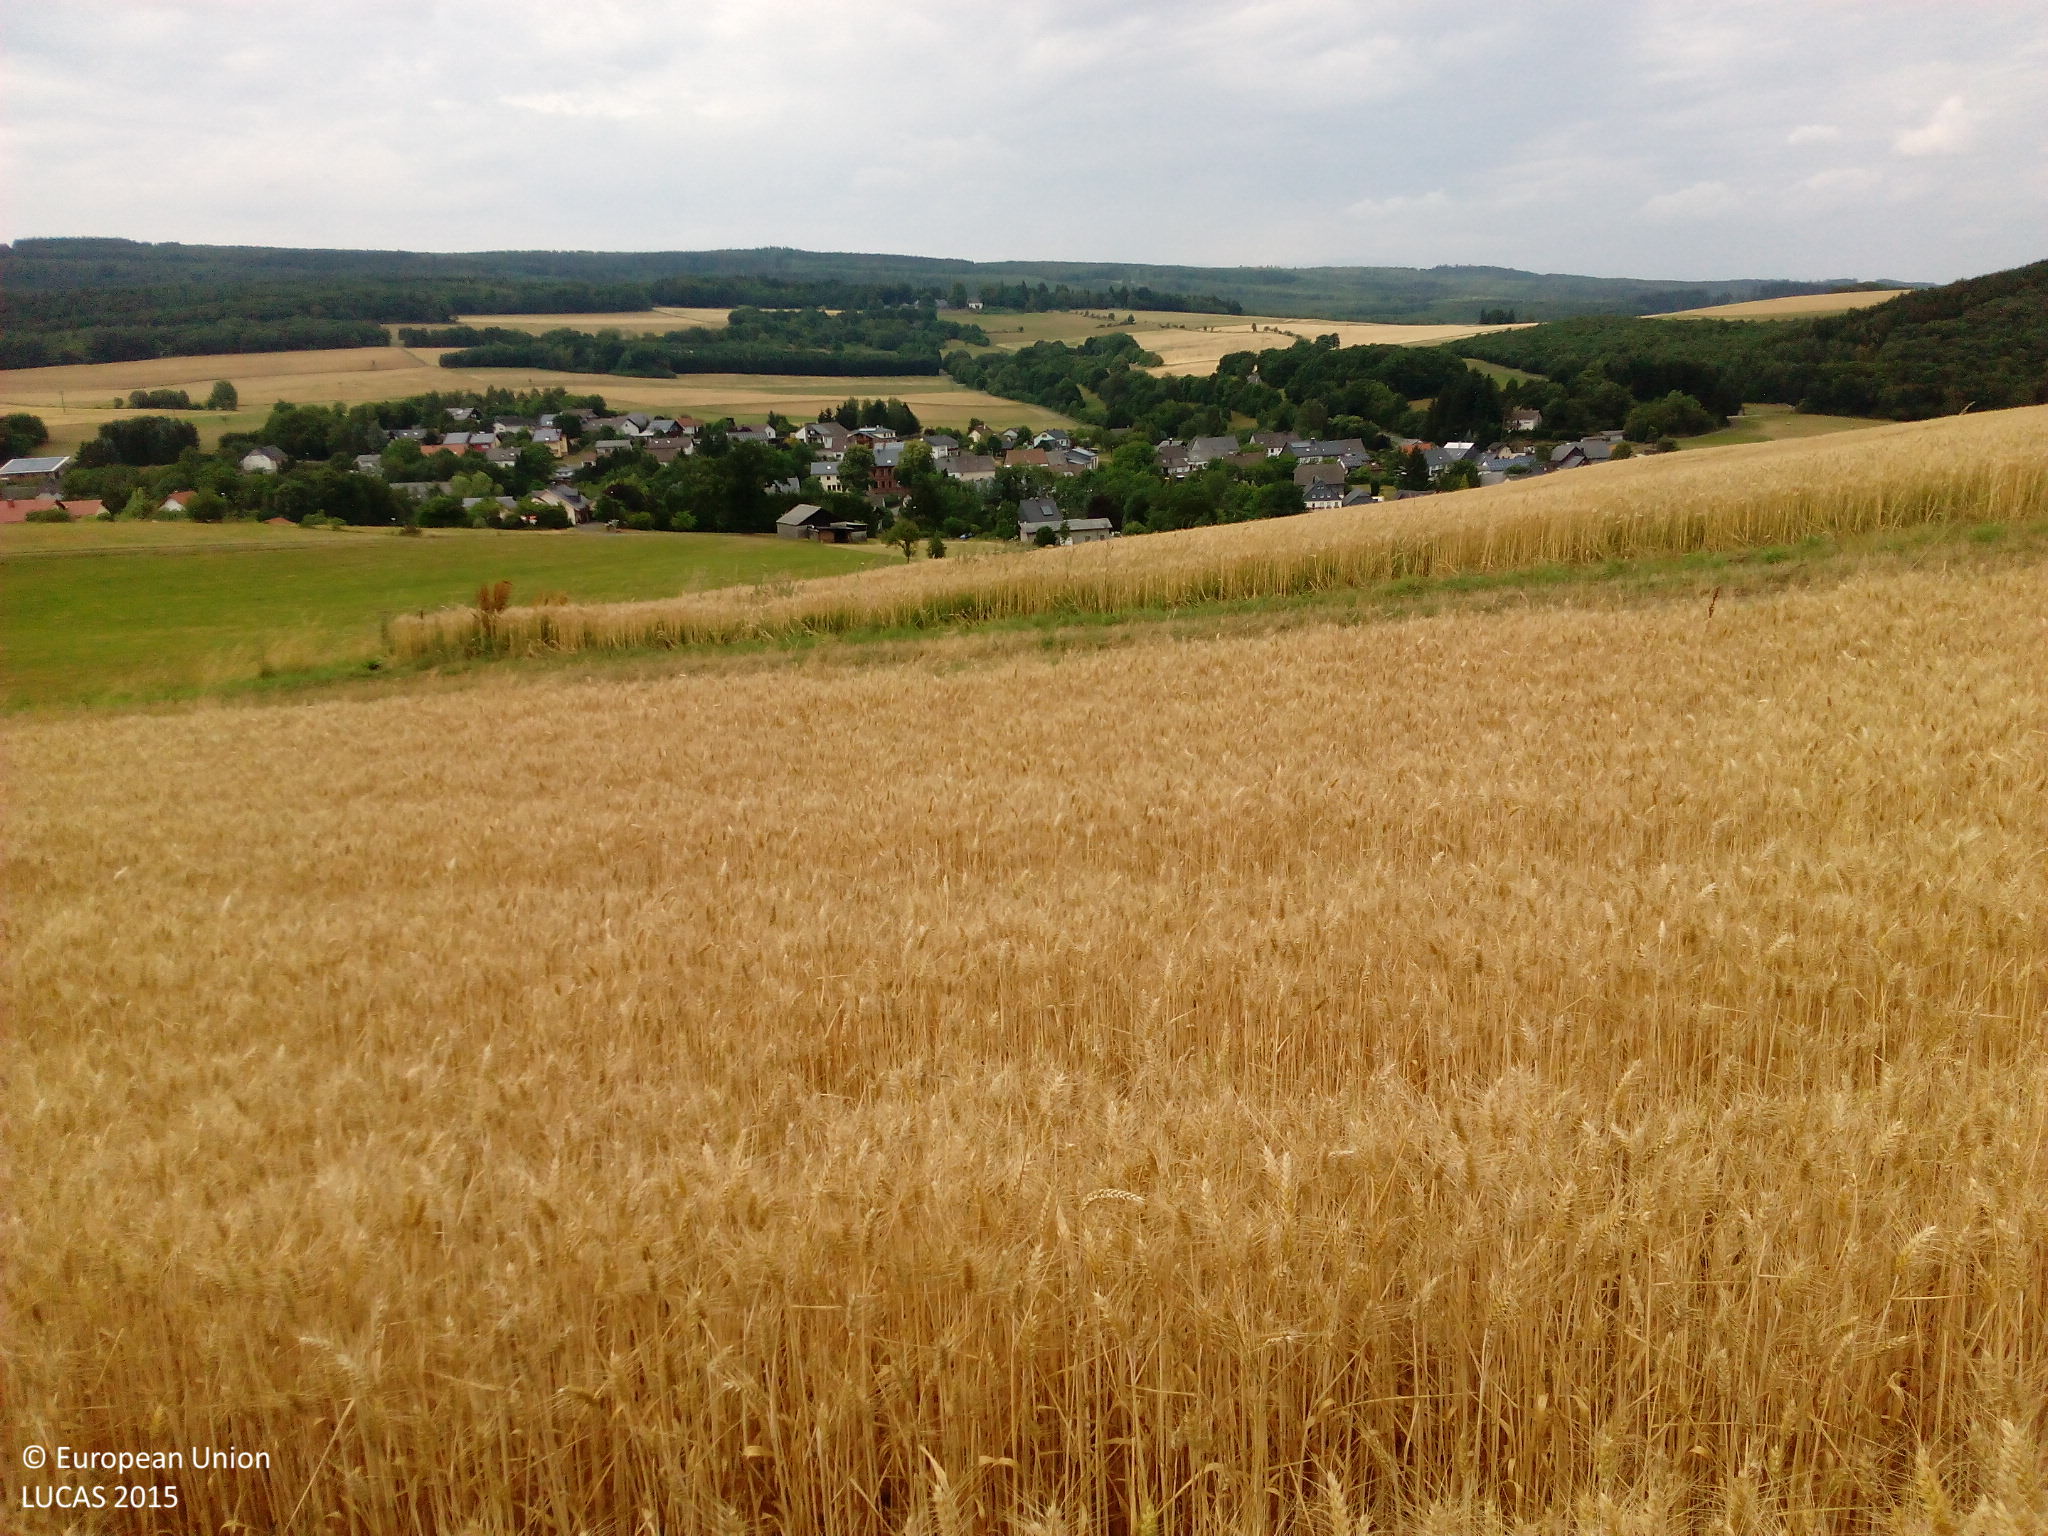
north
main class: Cropland
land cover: Common wheat
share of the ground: > 75 %
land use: Agriculture (excluding fallow land and kitchen gardens)
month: July
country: DE
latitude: 49.6997
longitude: 7.1857
